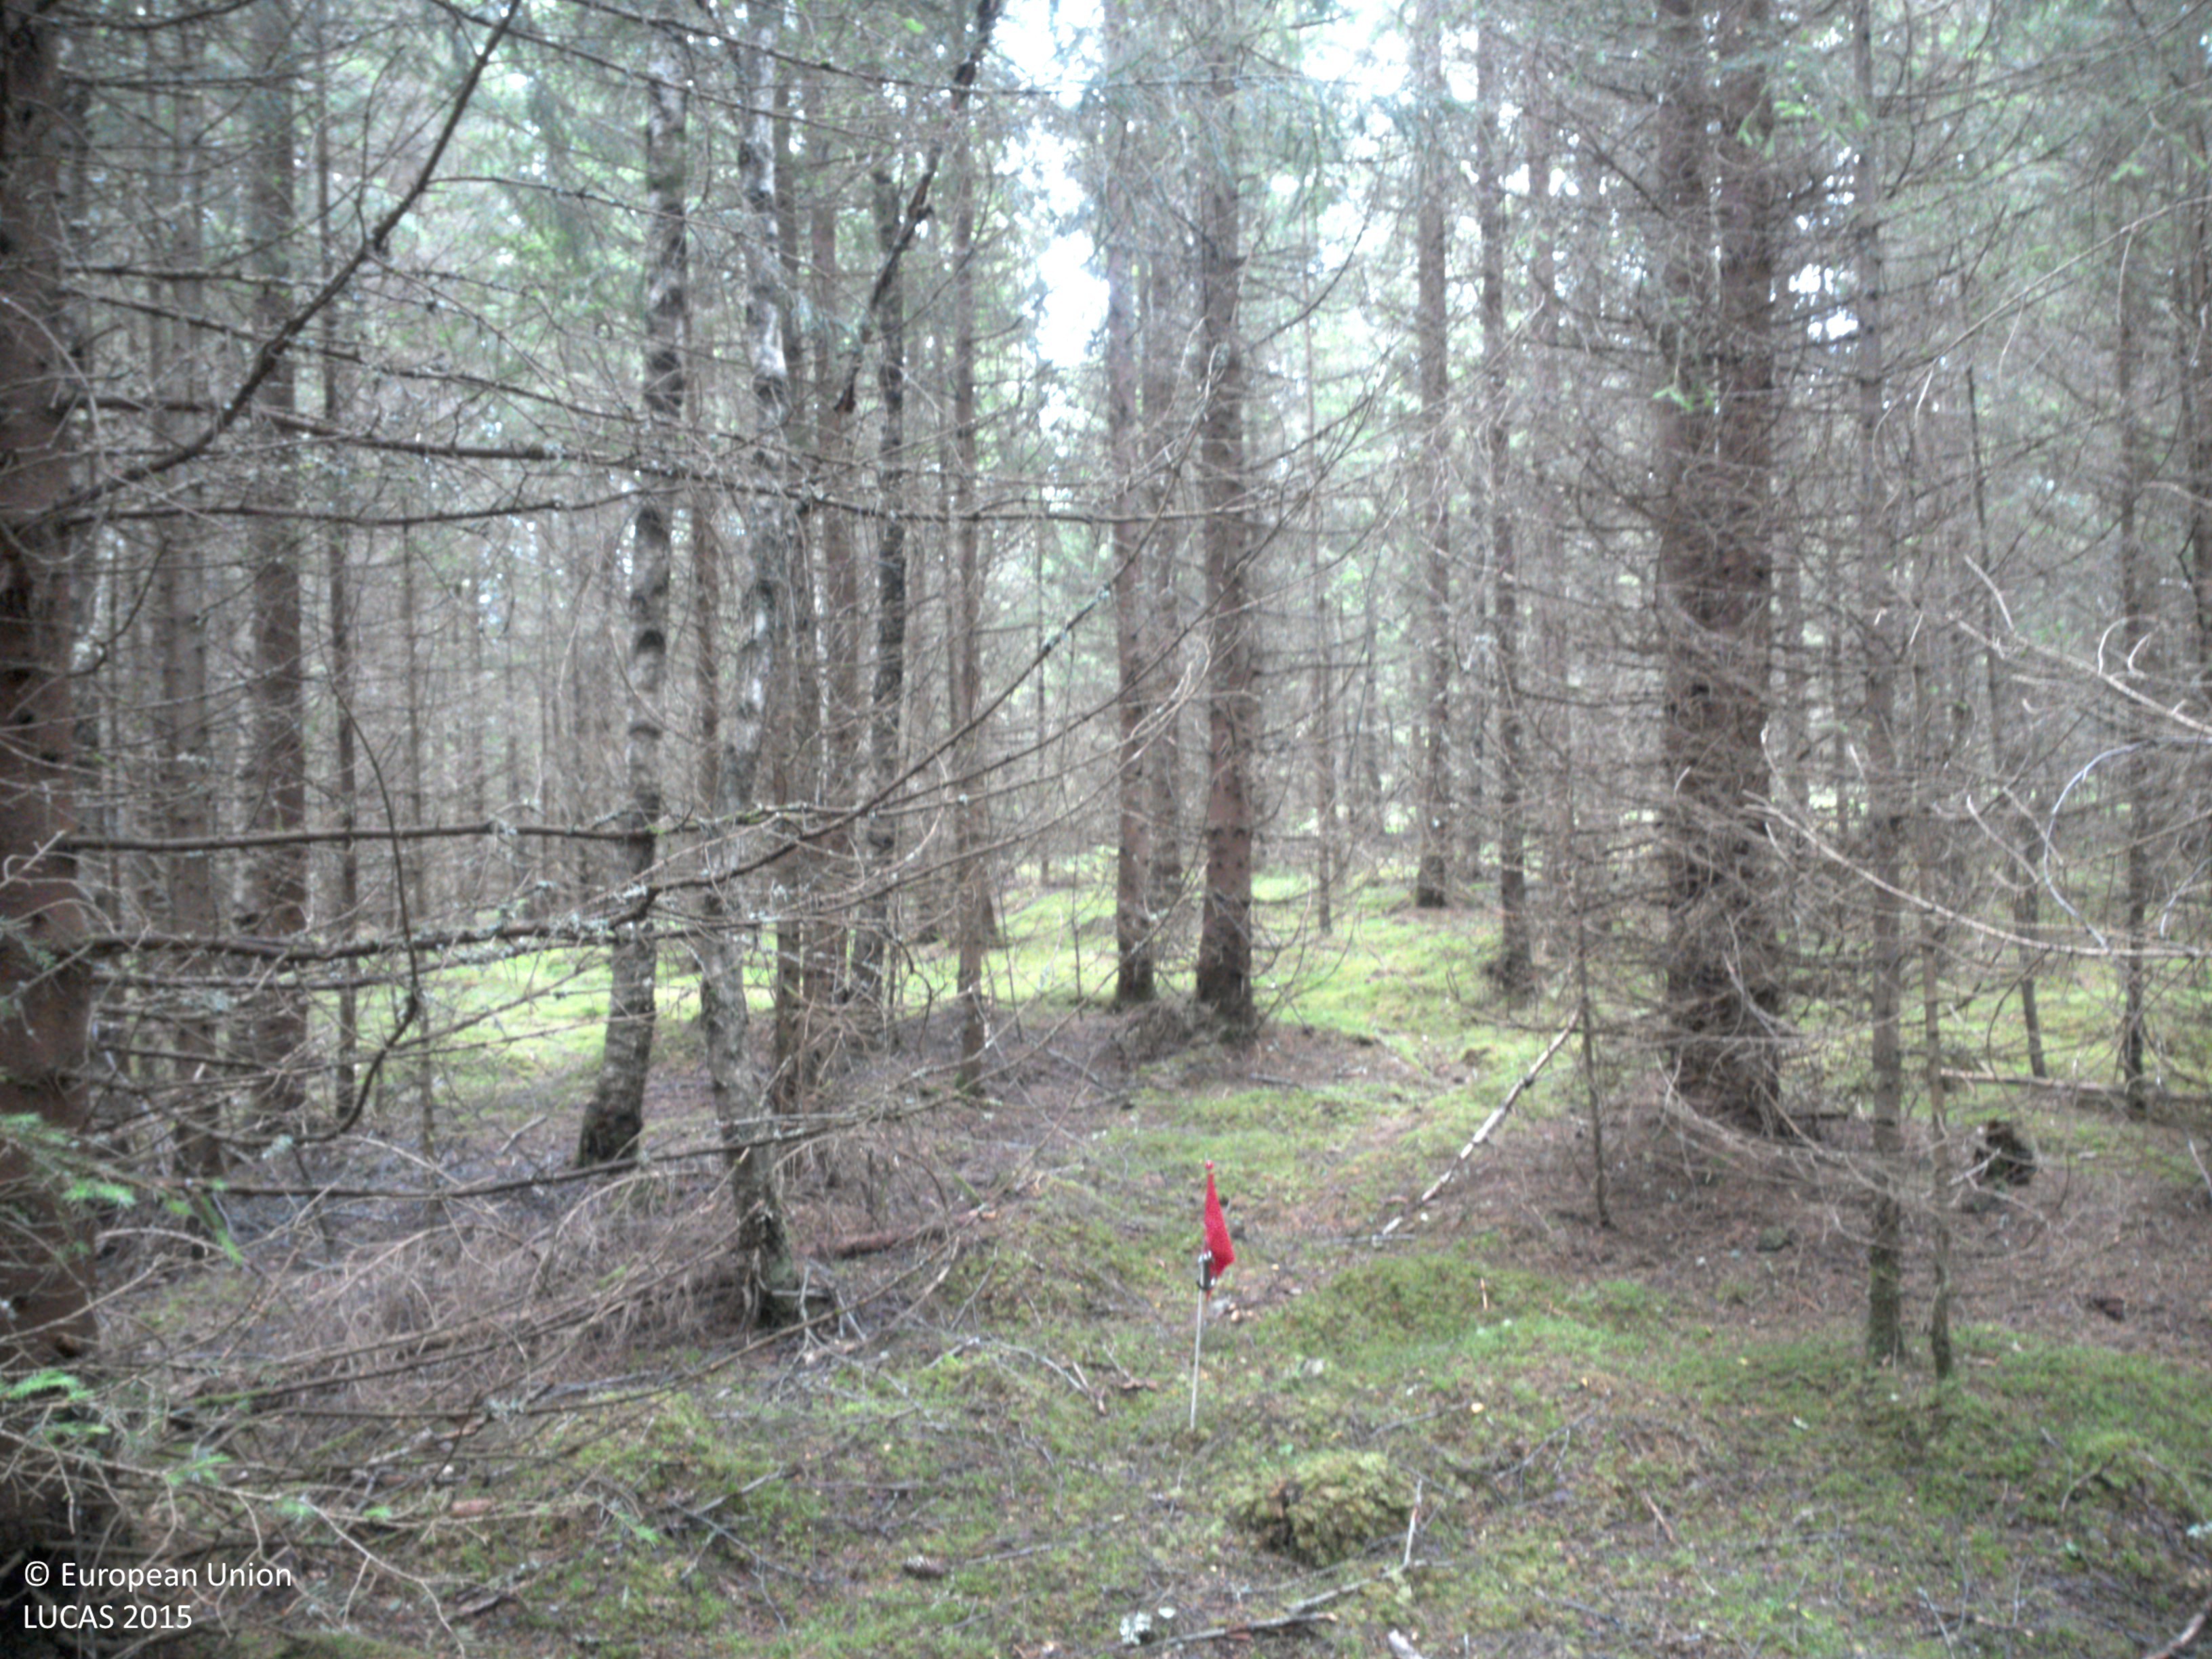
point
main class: Woodland
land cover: Spruce dominated coniferous woodland
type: boreal forest
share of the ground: > 75 %
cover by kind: coniferous forest trees 80 %, lichens and mosses 20 %
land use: Forestry
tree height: > 5 m
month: July
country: SE
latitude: 58.8351
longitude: 11.9533
